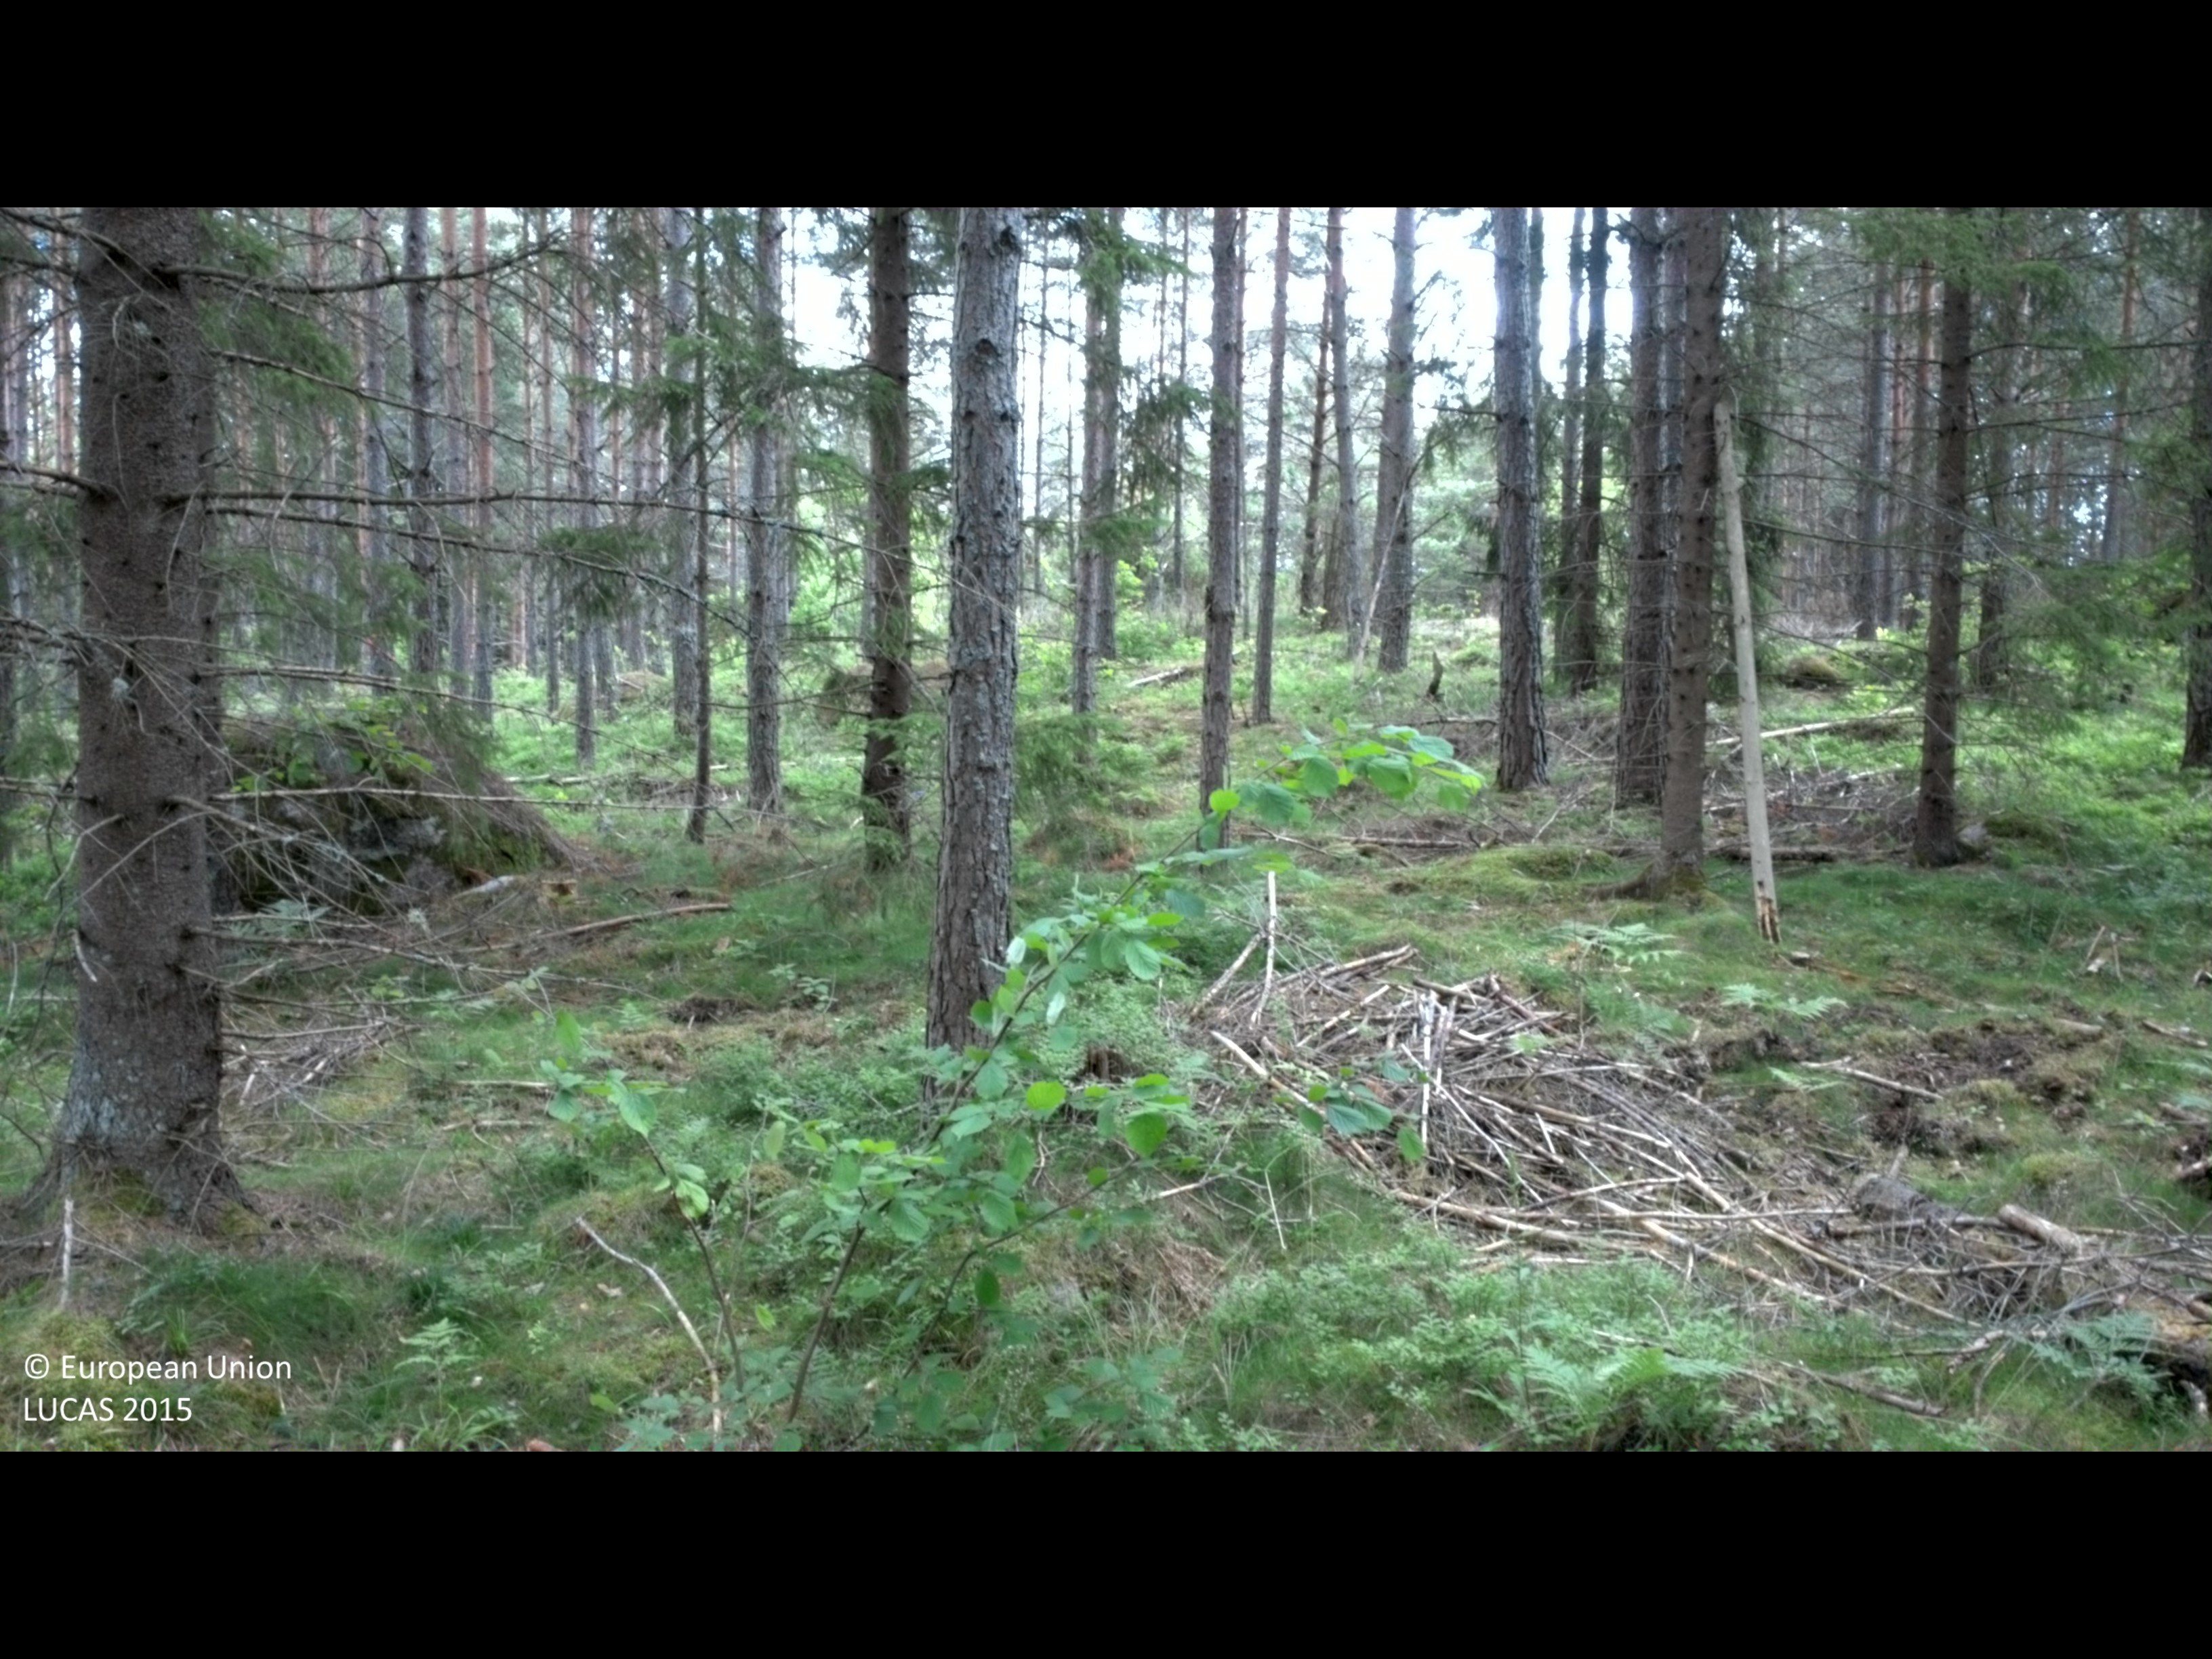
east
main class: Woodland
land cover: Other coniferous woodland
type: boreal forest
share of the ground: 50 - 75 %
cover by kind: coniferous forest trees 60 %, shrubs 25 %, herbaceous plants 10 %, broadleaved forest trees 5 %
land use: Forestry
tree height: > 5 m
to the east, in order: Other coniferous woodland; Pine dominated coniferous woodland; Rocks and stones; Other coniferous woodland; Paved roads, cycling and walking lanes; Broadleaved woodland; Tracks; Spruce dominated coniferous woodland; Pine dominated coniferous woodland; Tracks; Broadleaved woodland
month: July
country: SE
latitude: 57.9175
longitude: 16.1246
